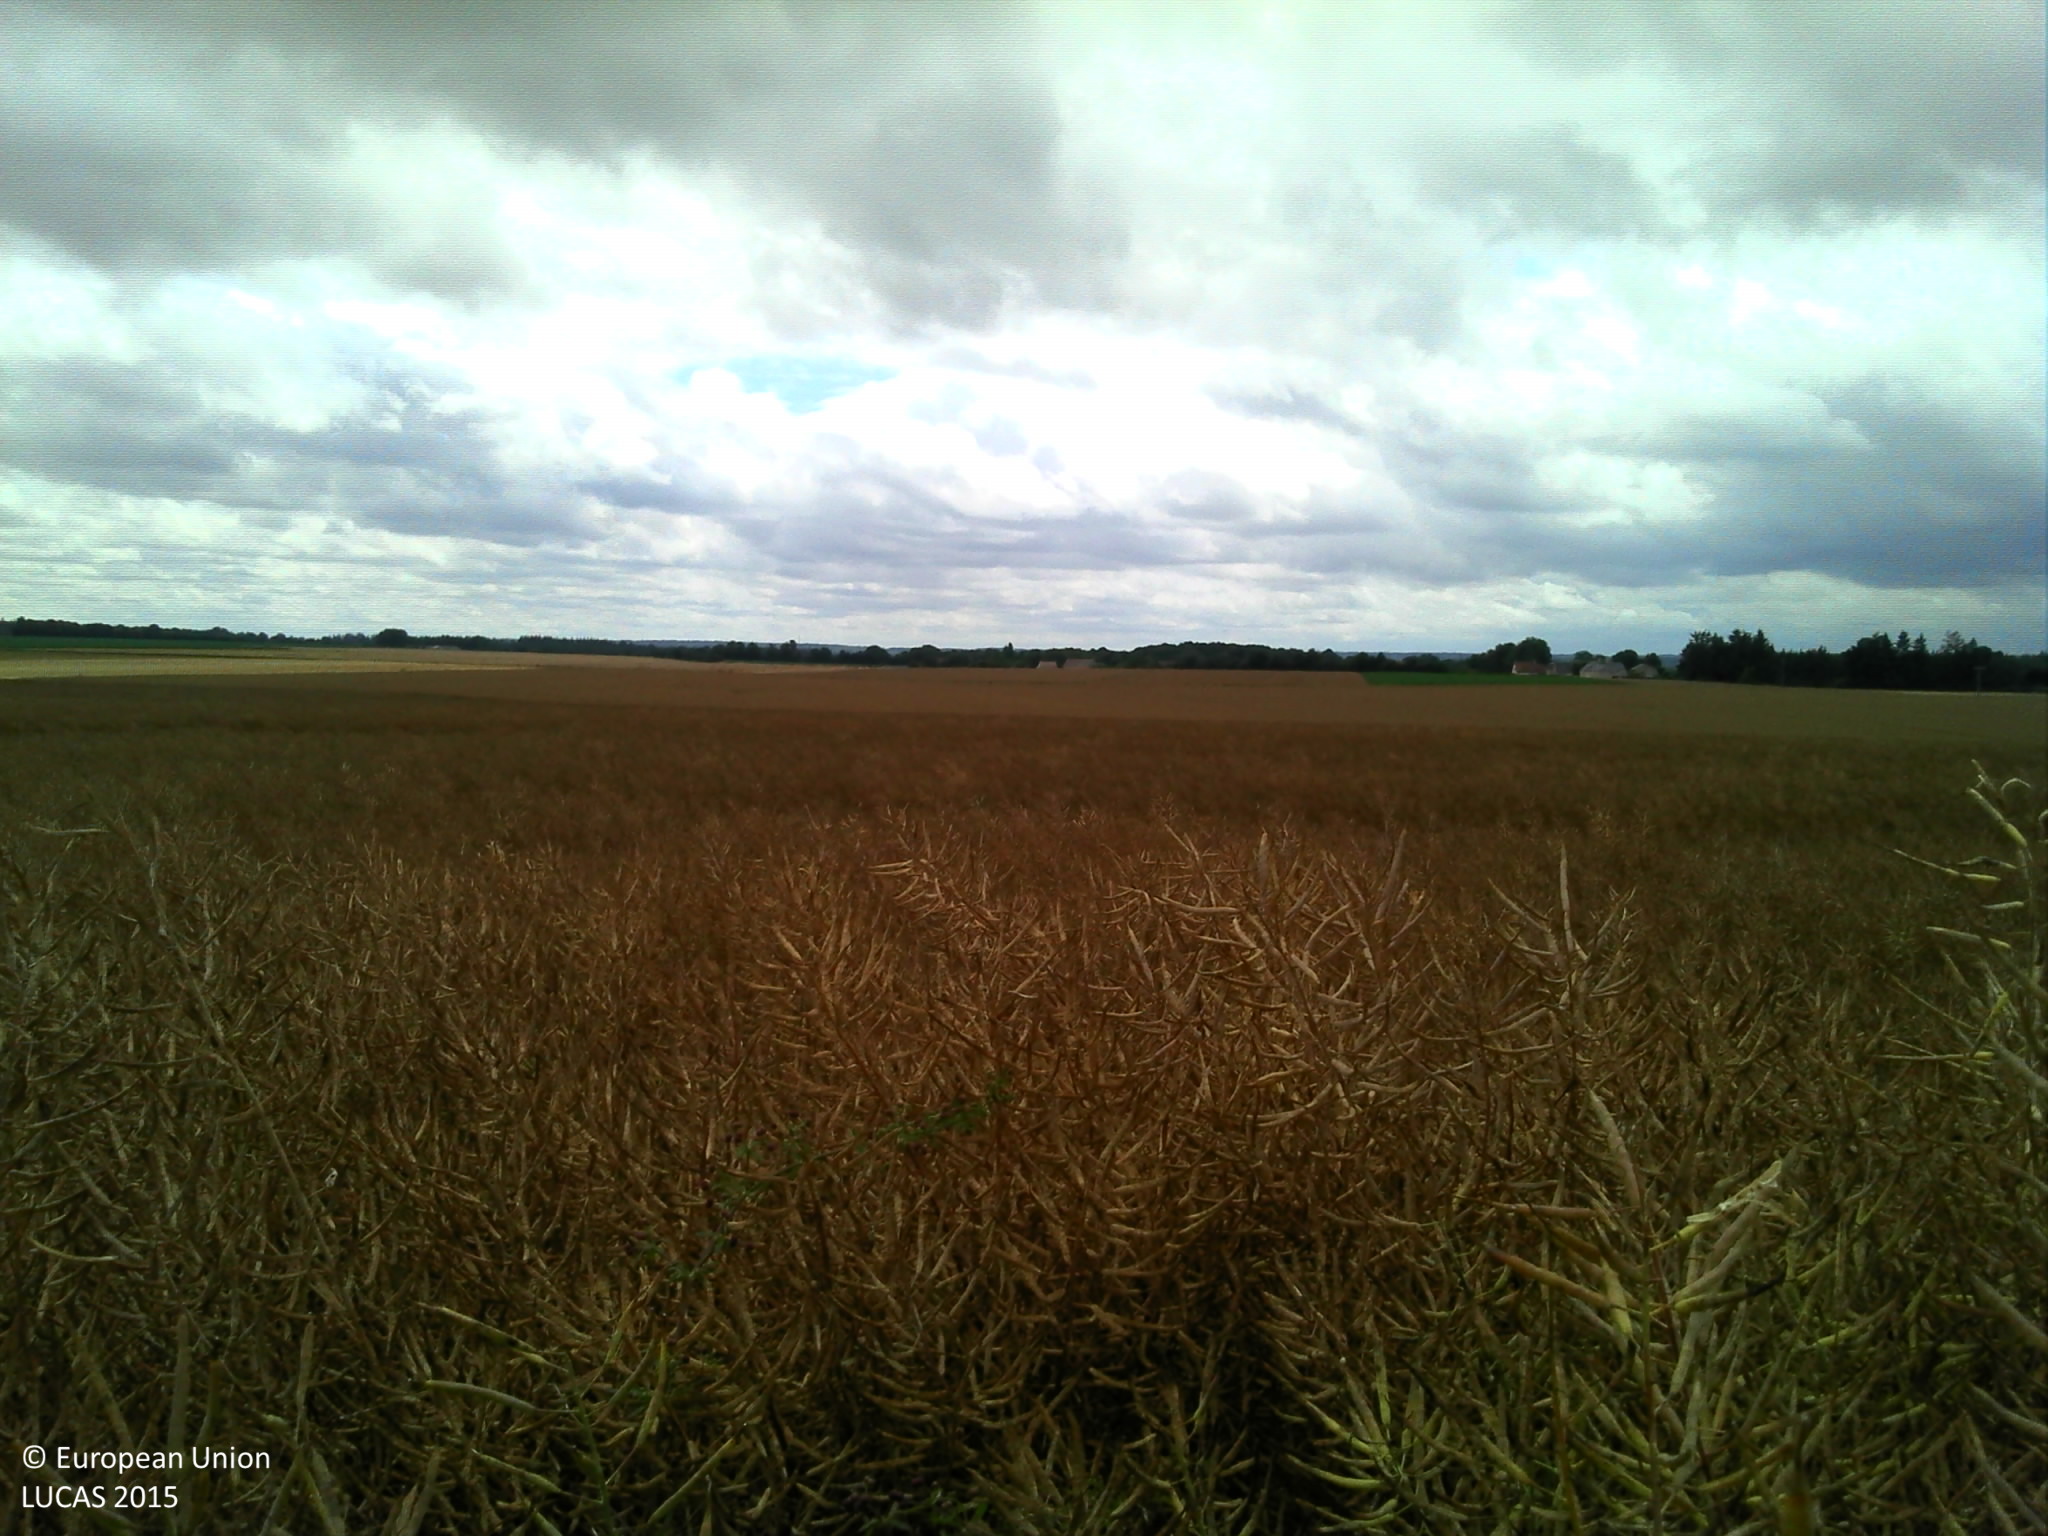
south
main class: Cropland
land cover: Rape and turnip rape
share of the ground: > 75 %
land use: Agriculture (excluding fallow land and kitchen gardens)
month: July
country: FR
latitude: 48.9915
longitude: -0.2974
